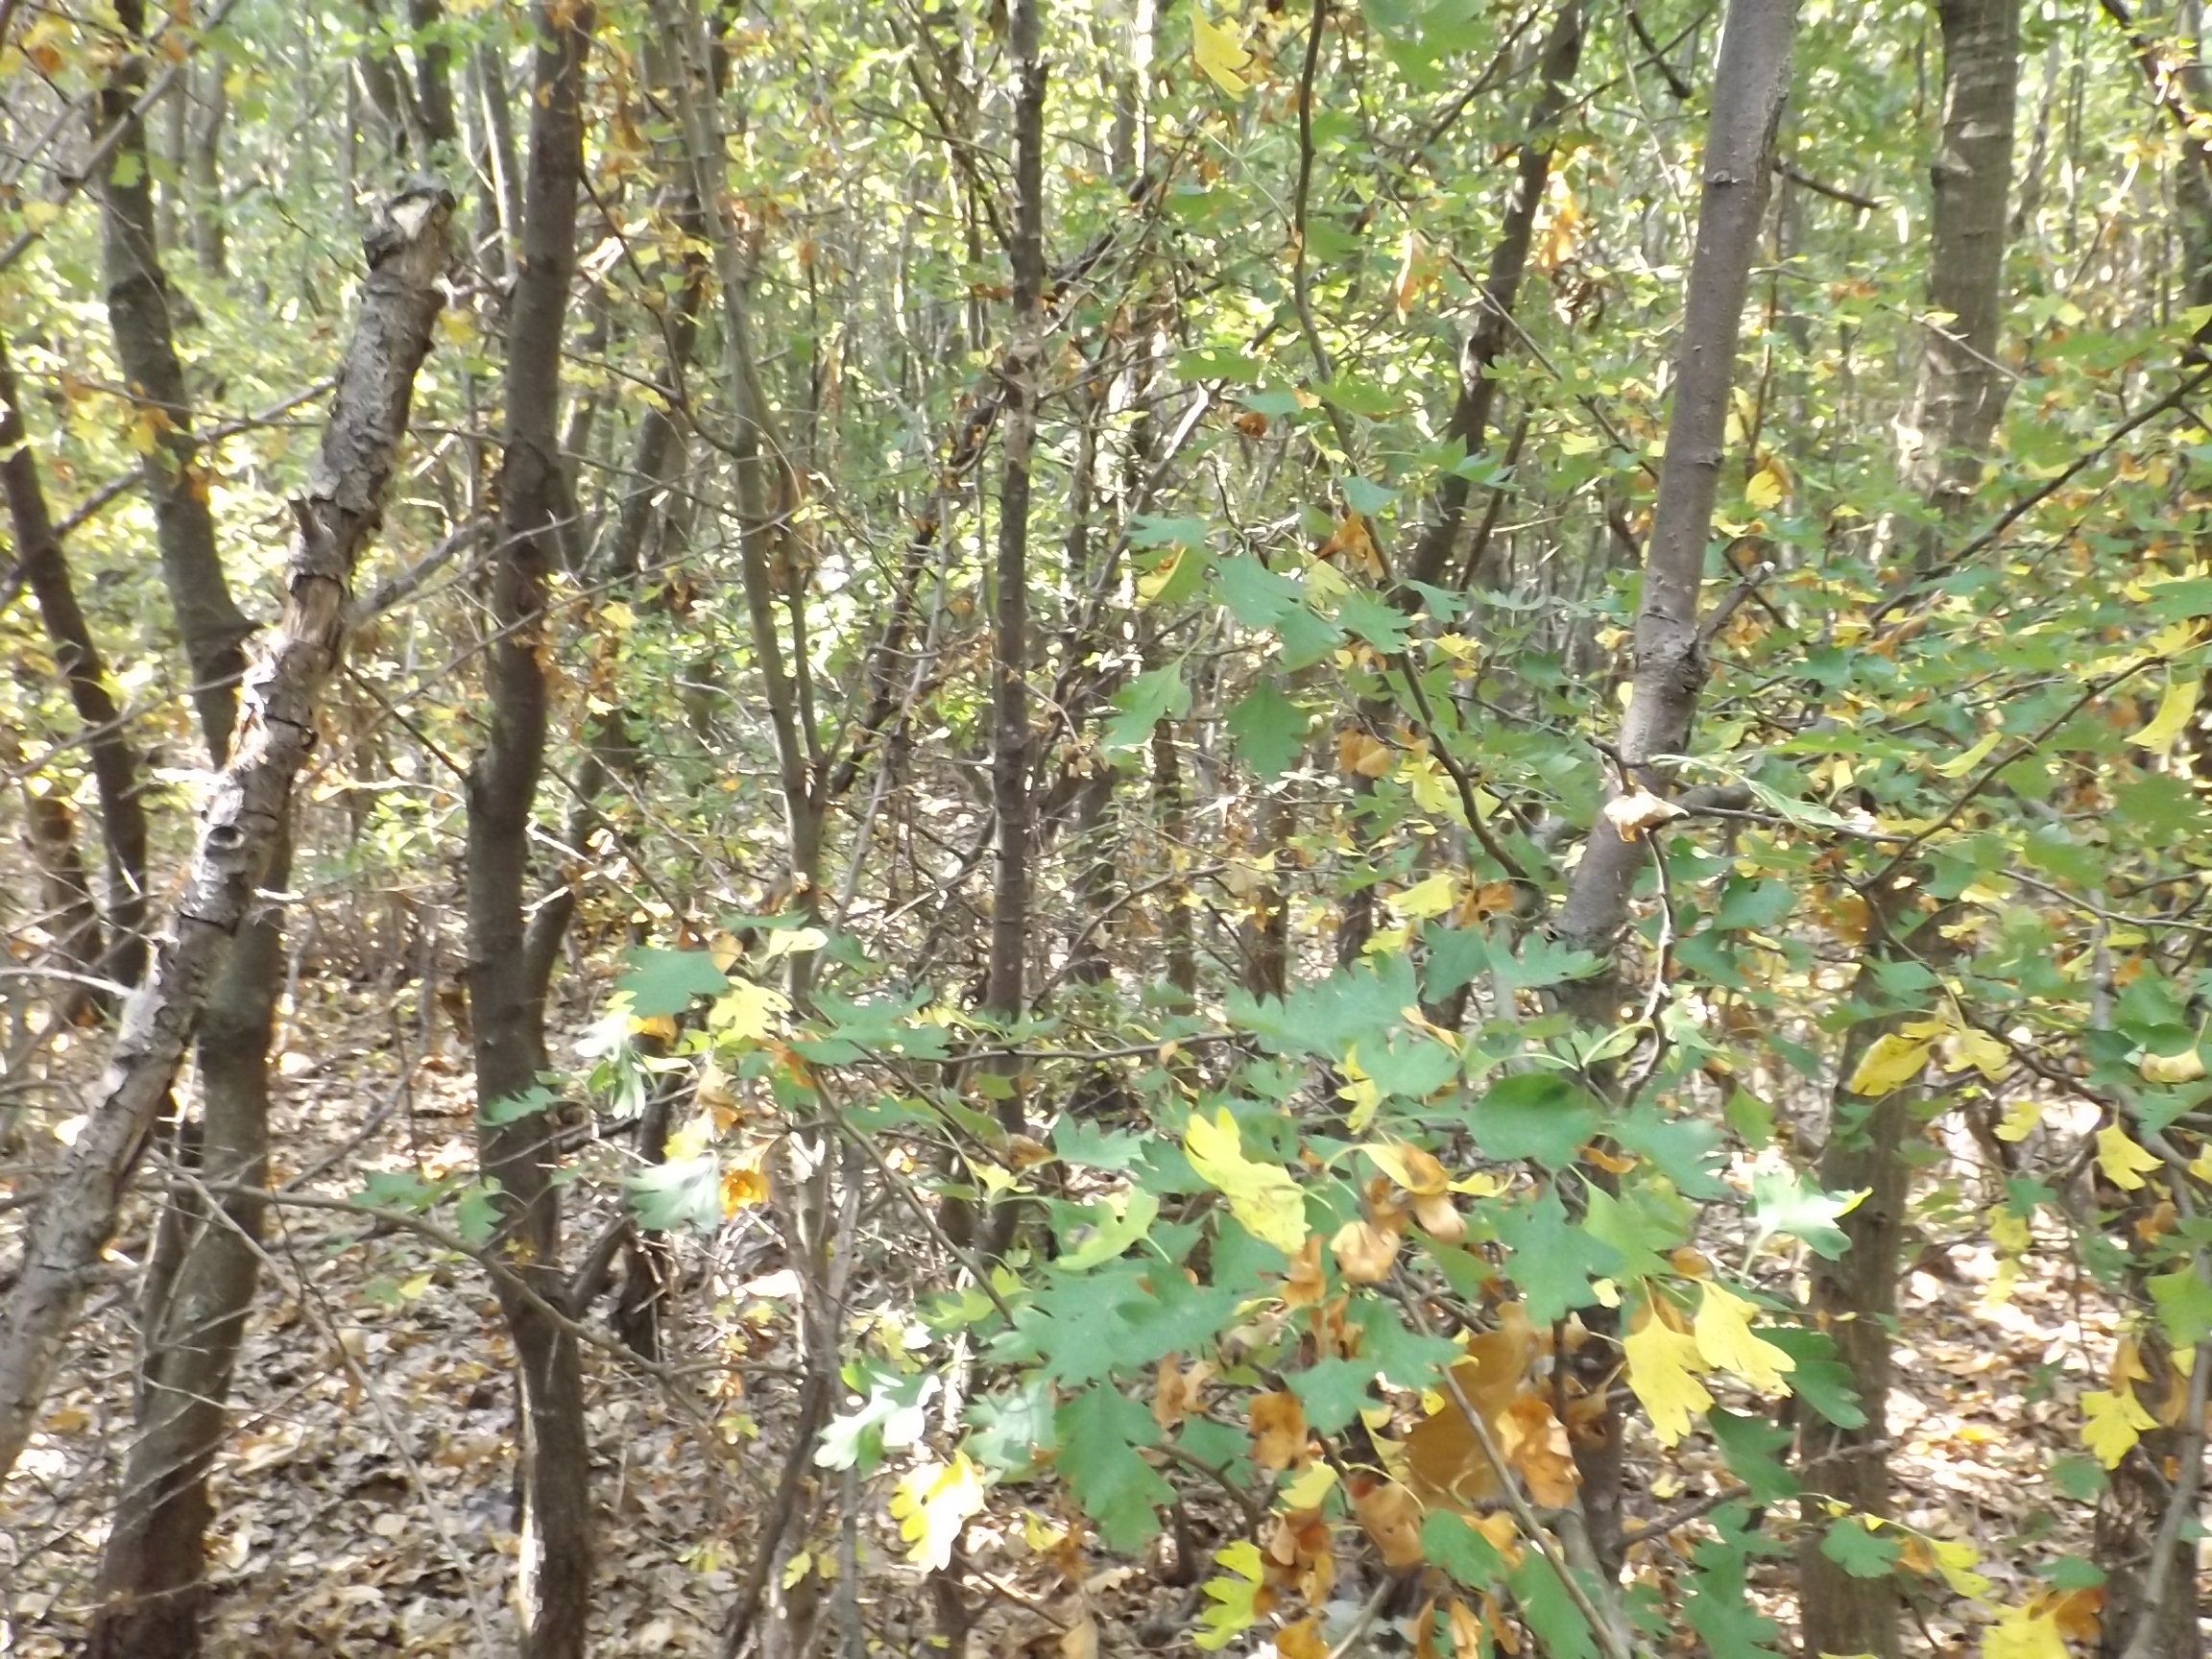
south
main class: Woodland
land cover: Broadleaved woodland
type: mesophytic deciduous forest
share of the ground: > 75 %
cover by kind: broadleaved forest trees 95 %, herbaceous plants 5 %
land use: Forestry
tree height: > 5 m
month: July
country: BG
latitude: 43.4790
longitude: 27.3739
